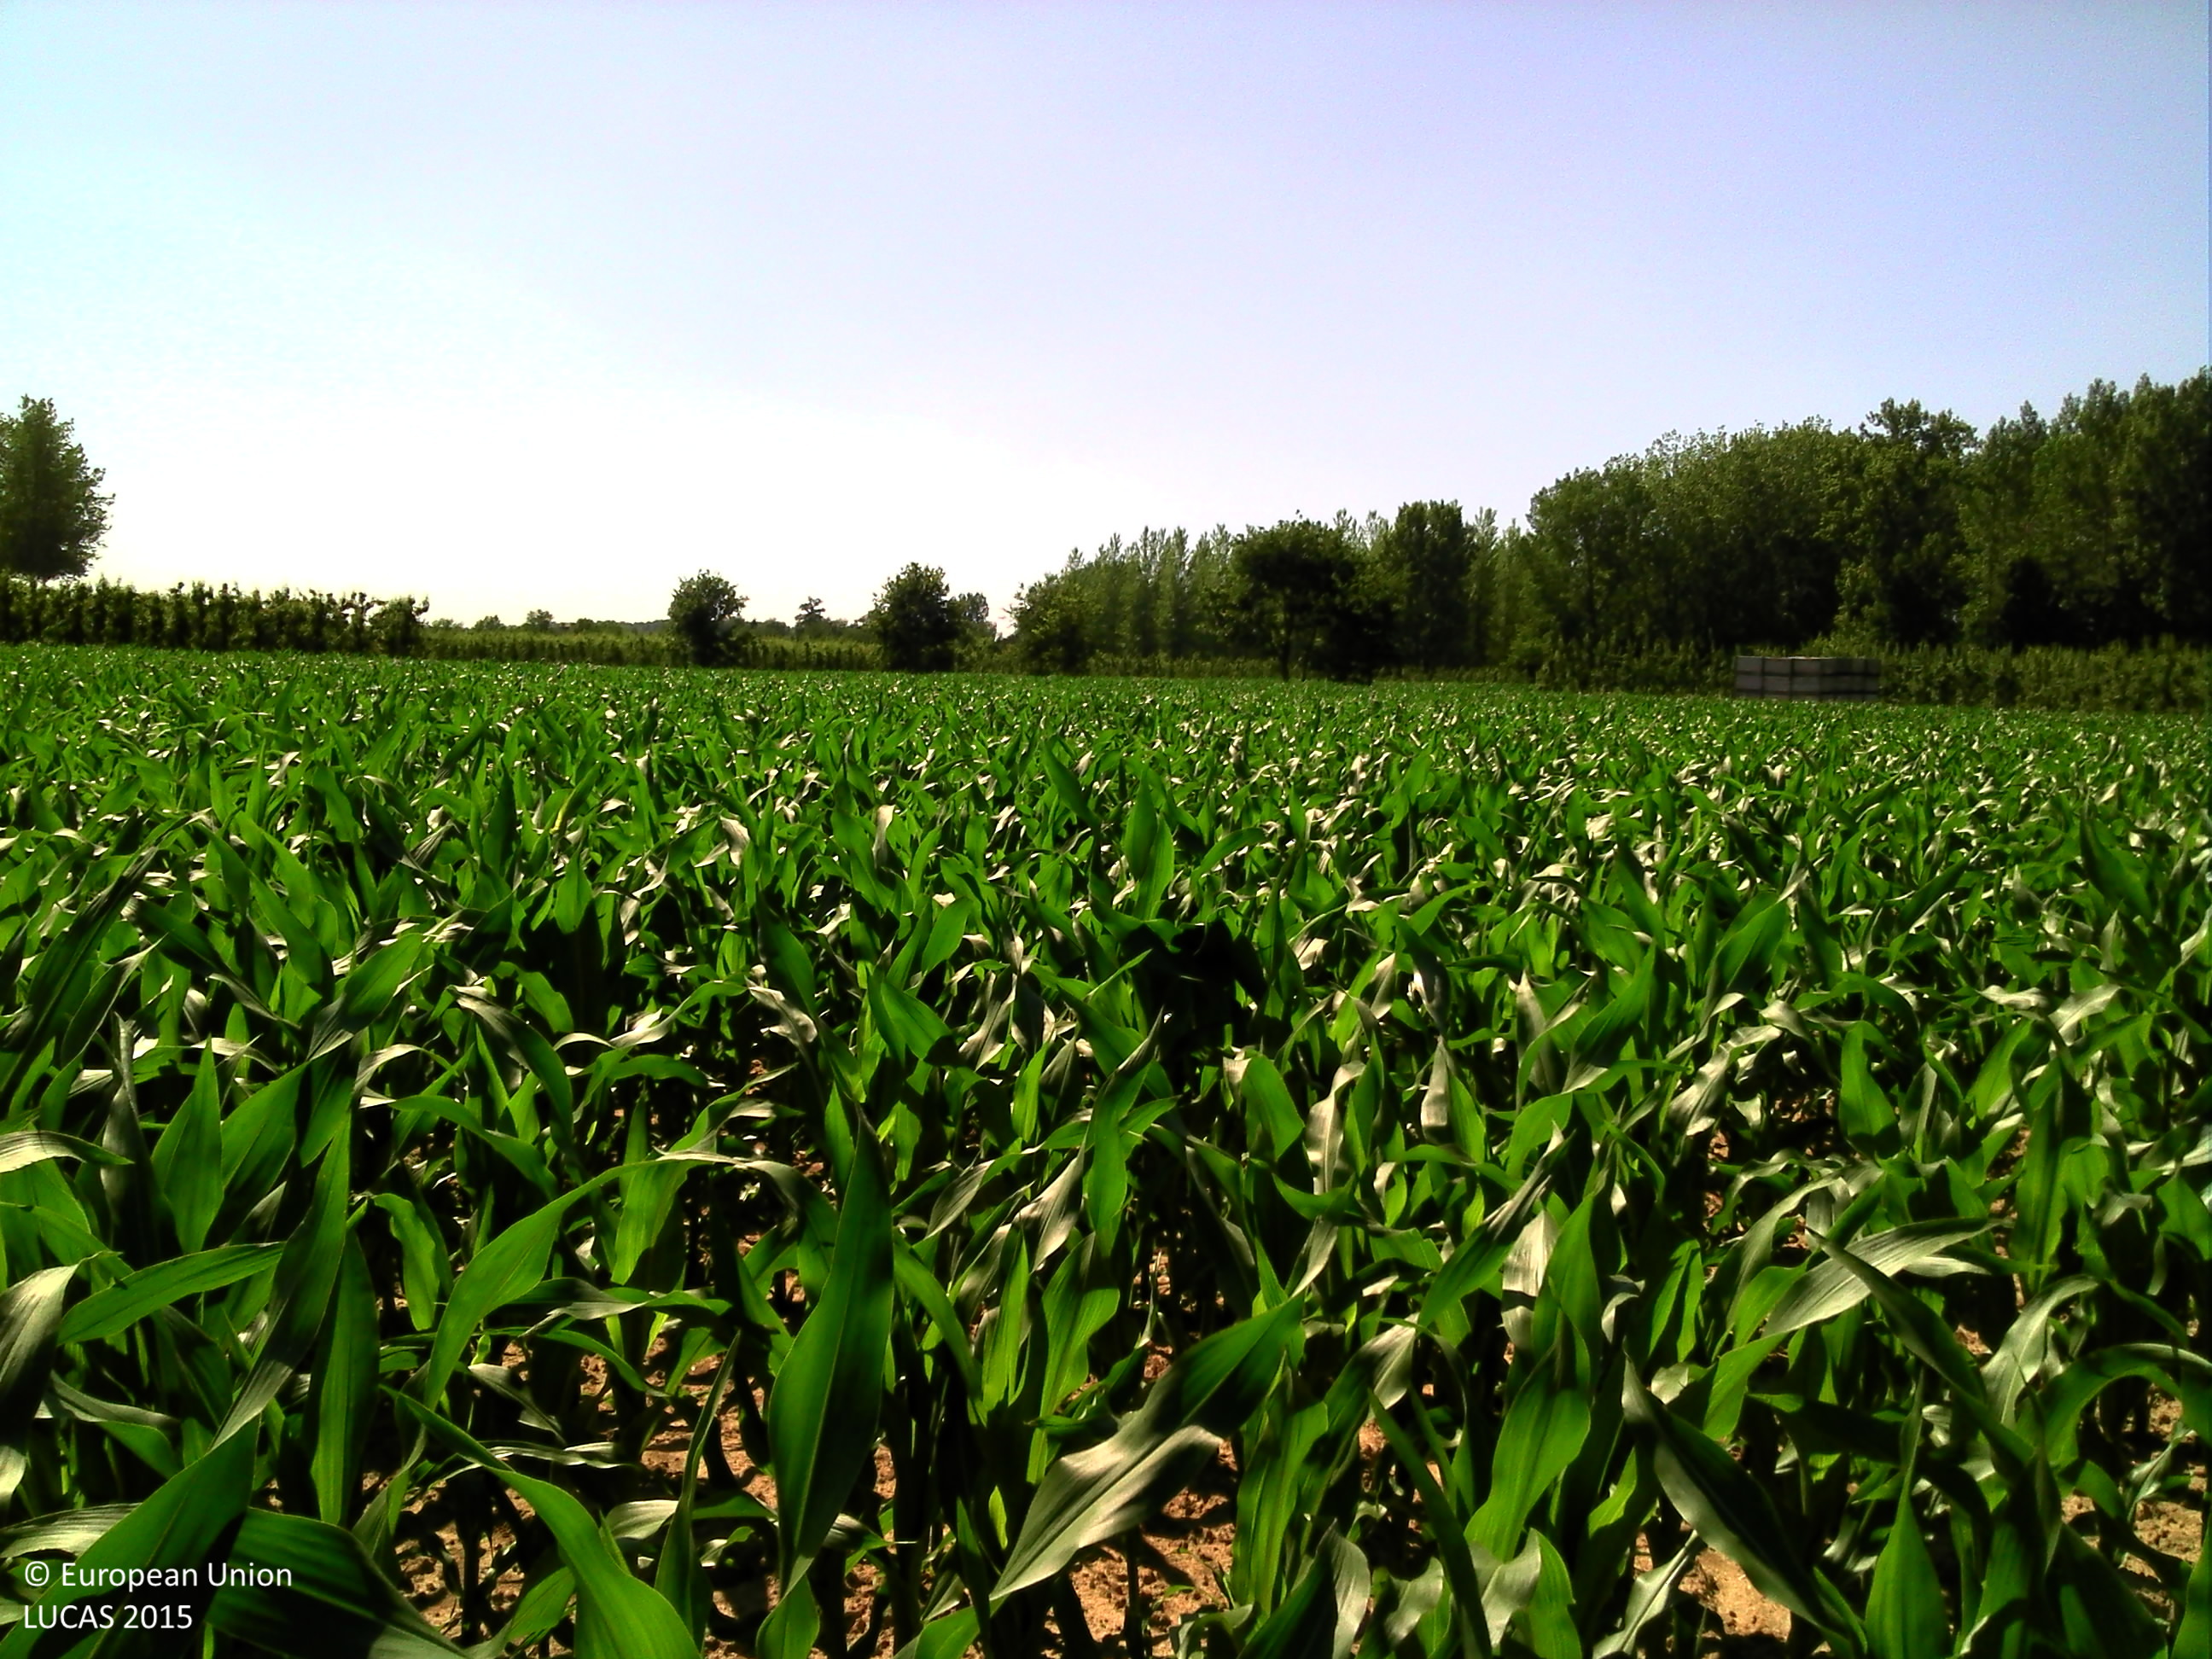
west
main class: Cropland
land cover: Maize
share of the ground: > 75 %
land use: Agriculture (excluding fallow land and kitchen gardens)
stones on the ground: < 10 %
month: June
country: BE
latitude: 50.8426
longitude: 5.2686
